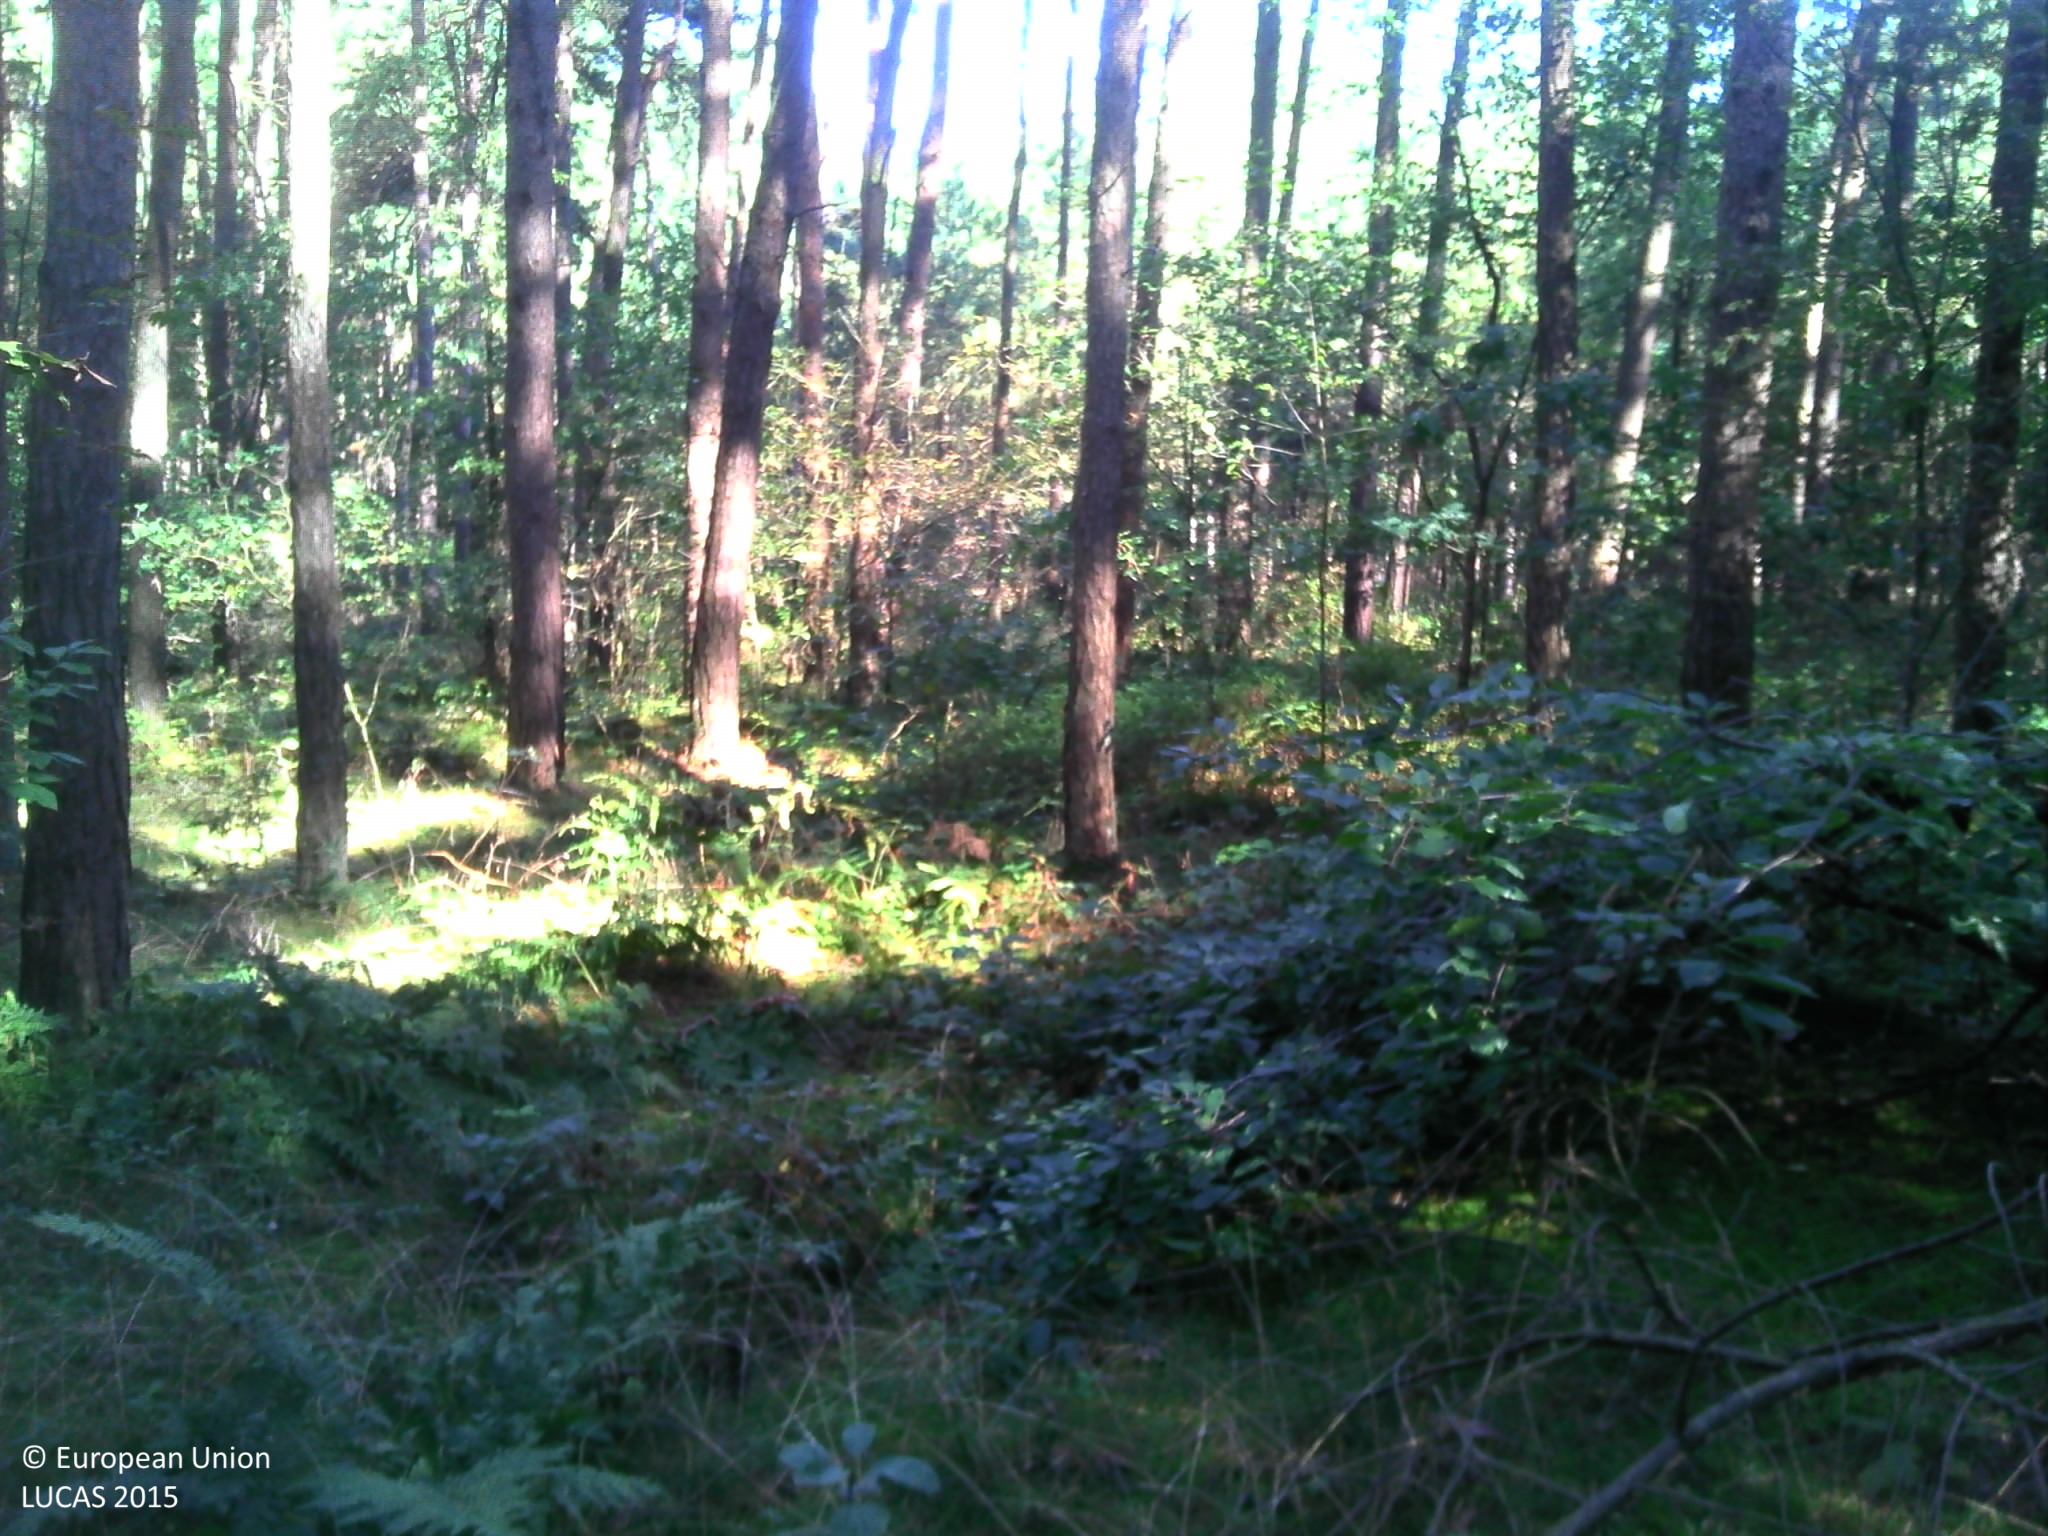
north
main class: Woodland
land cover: Pine dominated coniferous woodland
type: exotic forest
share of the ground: > 75 %
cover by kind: coniferous forest trees 100 %
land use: Forestry
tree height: > 5 m
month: September
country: BE
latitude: 51.2354
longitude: 4.7688
